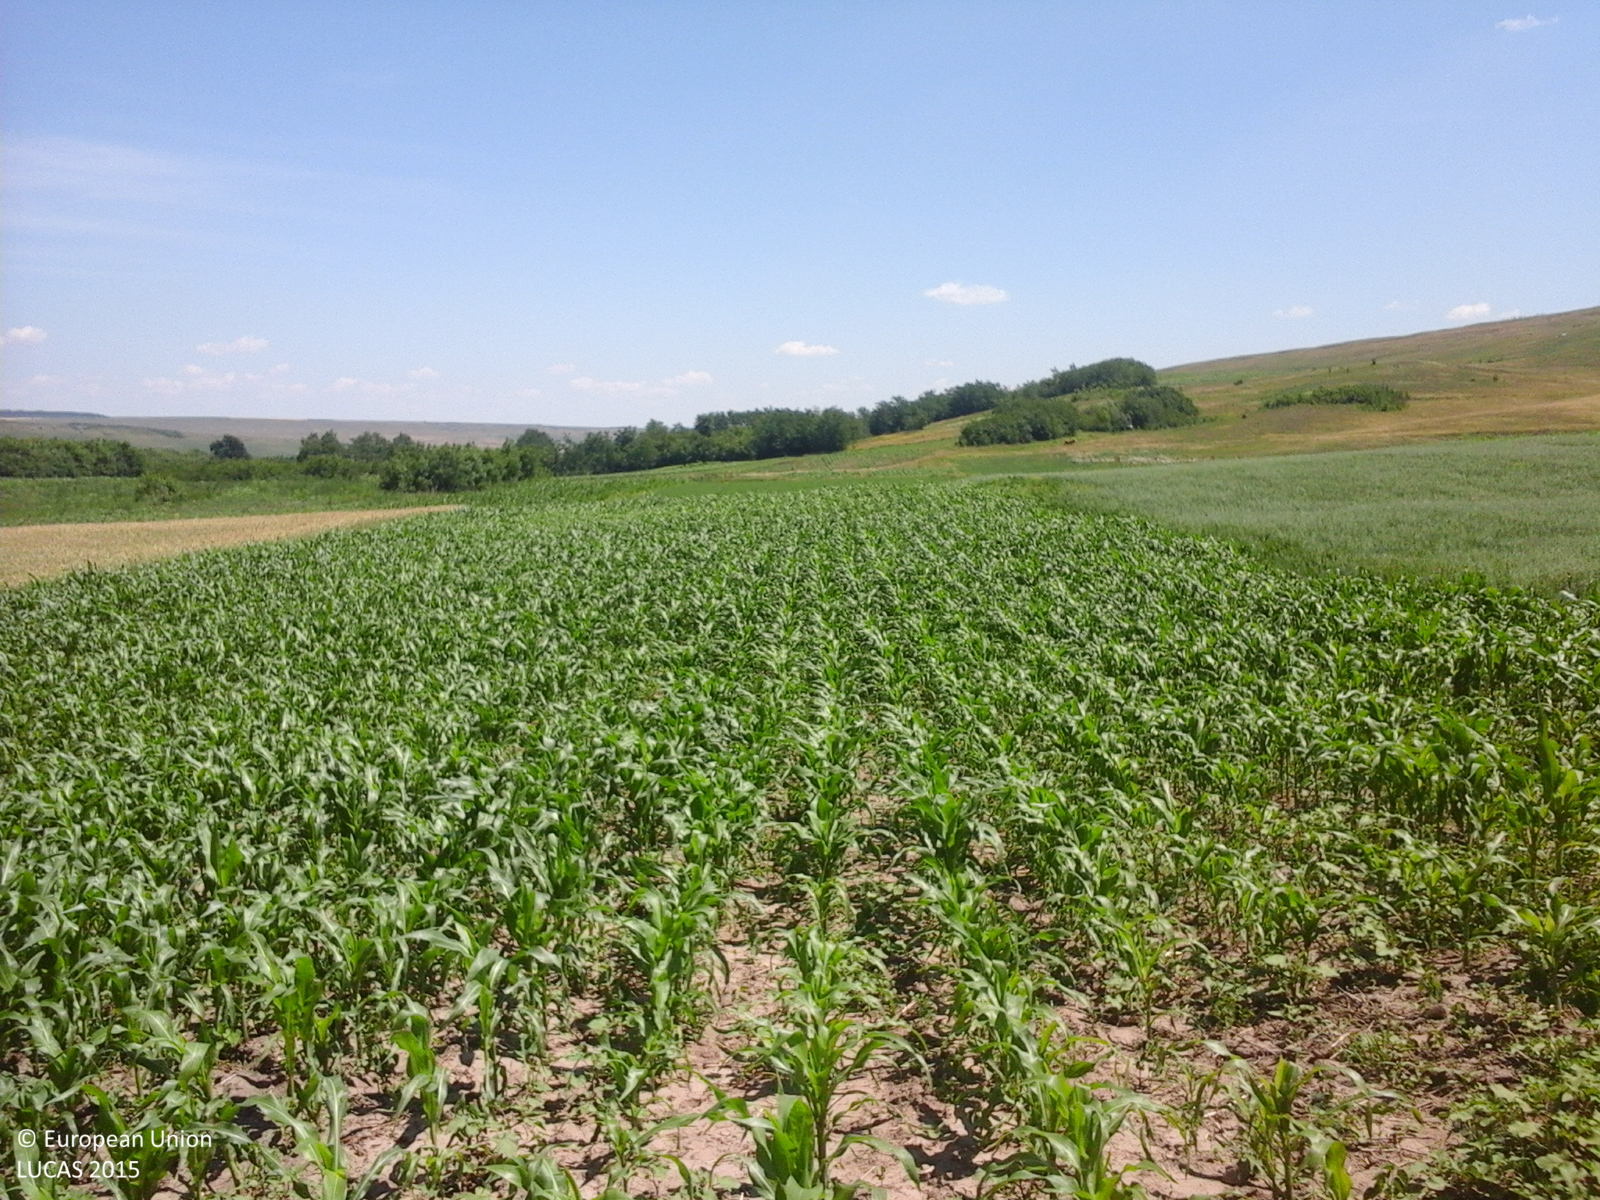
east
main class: Cropland
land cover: Maize
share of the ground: 25 - 50 %
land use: Agriculture (excluding fallow land and kitchen gardens)
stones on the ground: < 10 %
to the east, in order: Maize; Tracks; Lucerne; Maize; Spontaneously vegetated surfaces; Ditches and canals; Spontaneously vegetated surfaces; Maize
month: June
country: RO
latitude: 47.8653
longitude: 26.8788
